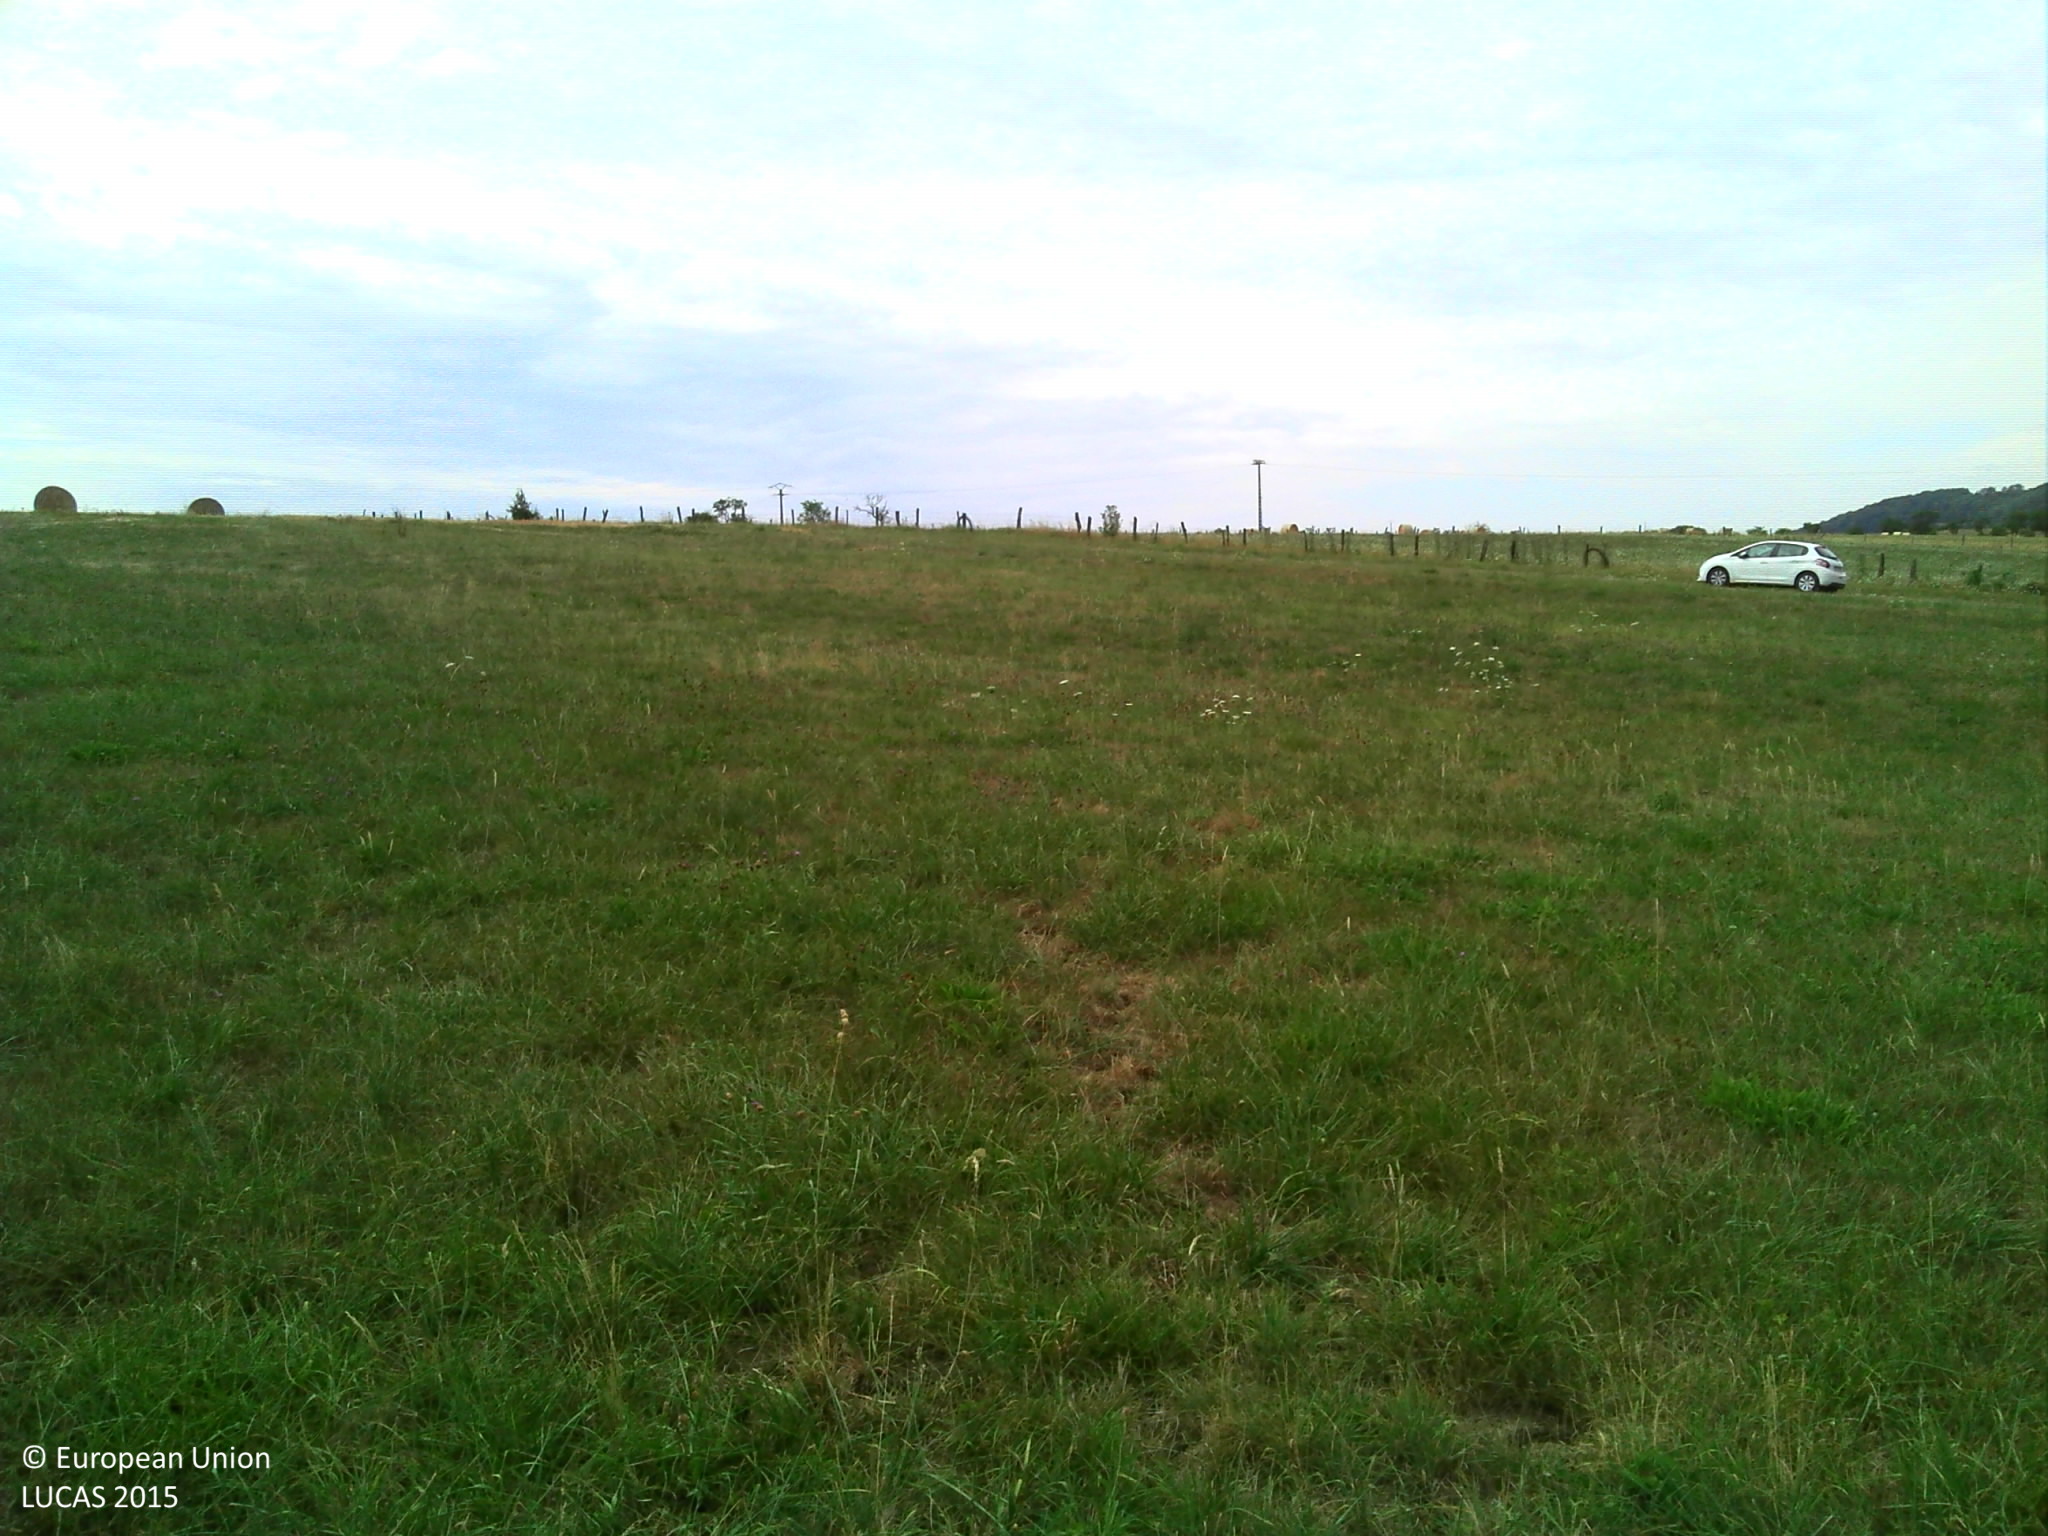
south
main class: Grassland
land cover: Grassland without tree/shrub cover
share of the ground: > 75 %
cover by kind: herbaceous plants 100 %
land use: Agriculture (excluding fallow land and kitchen gardens)
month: July
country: FR
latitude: 48.4038
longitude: 6.0152
